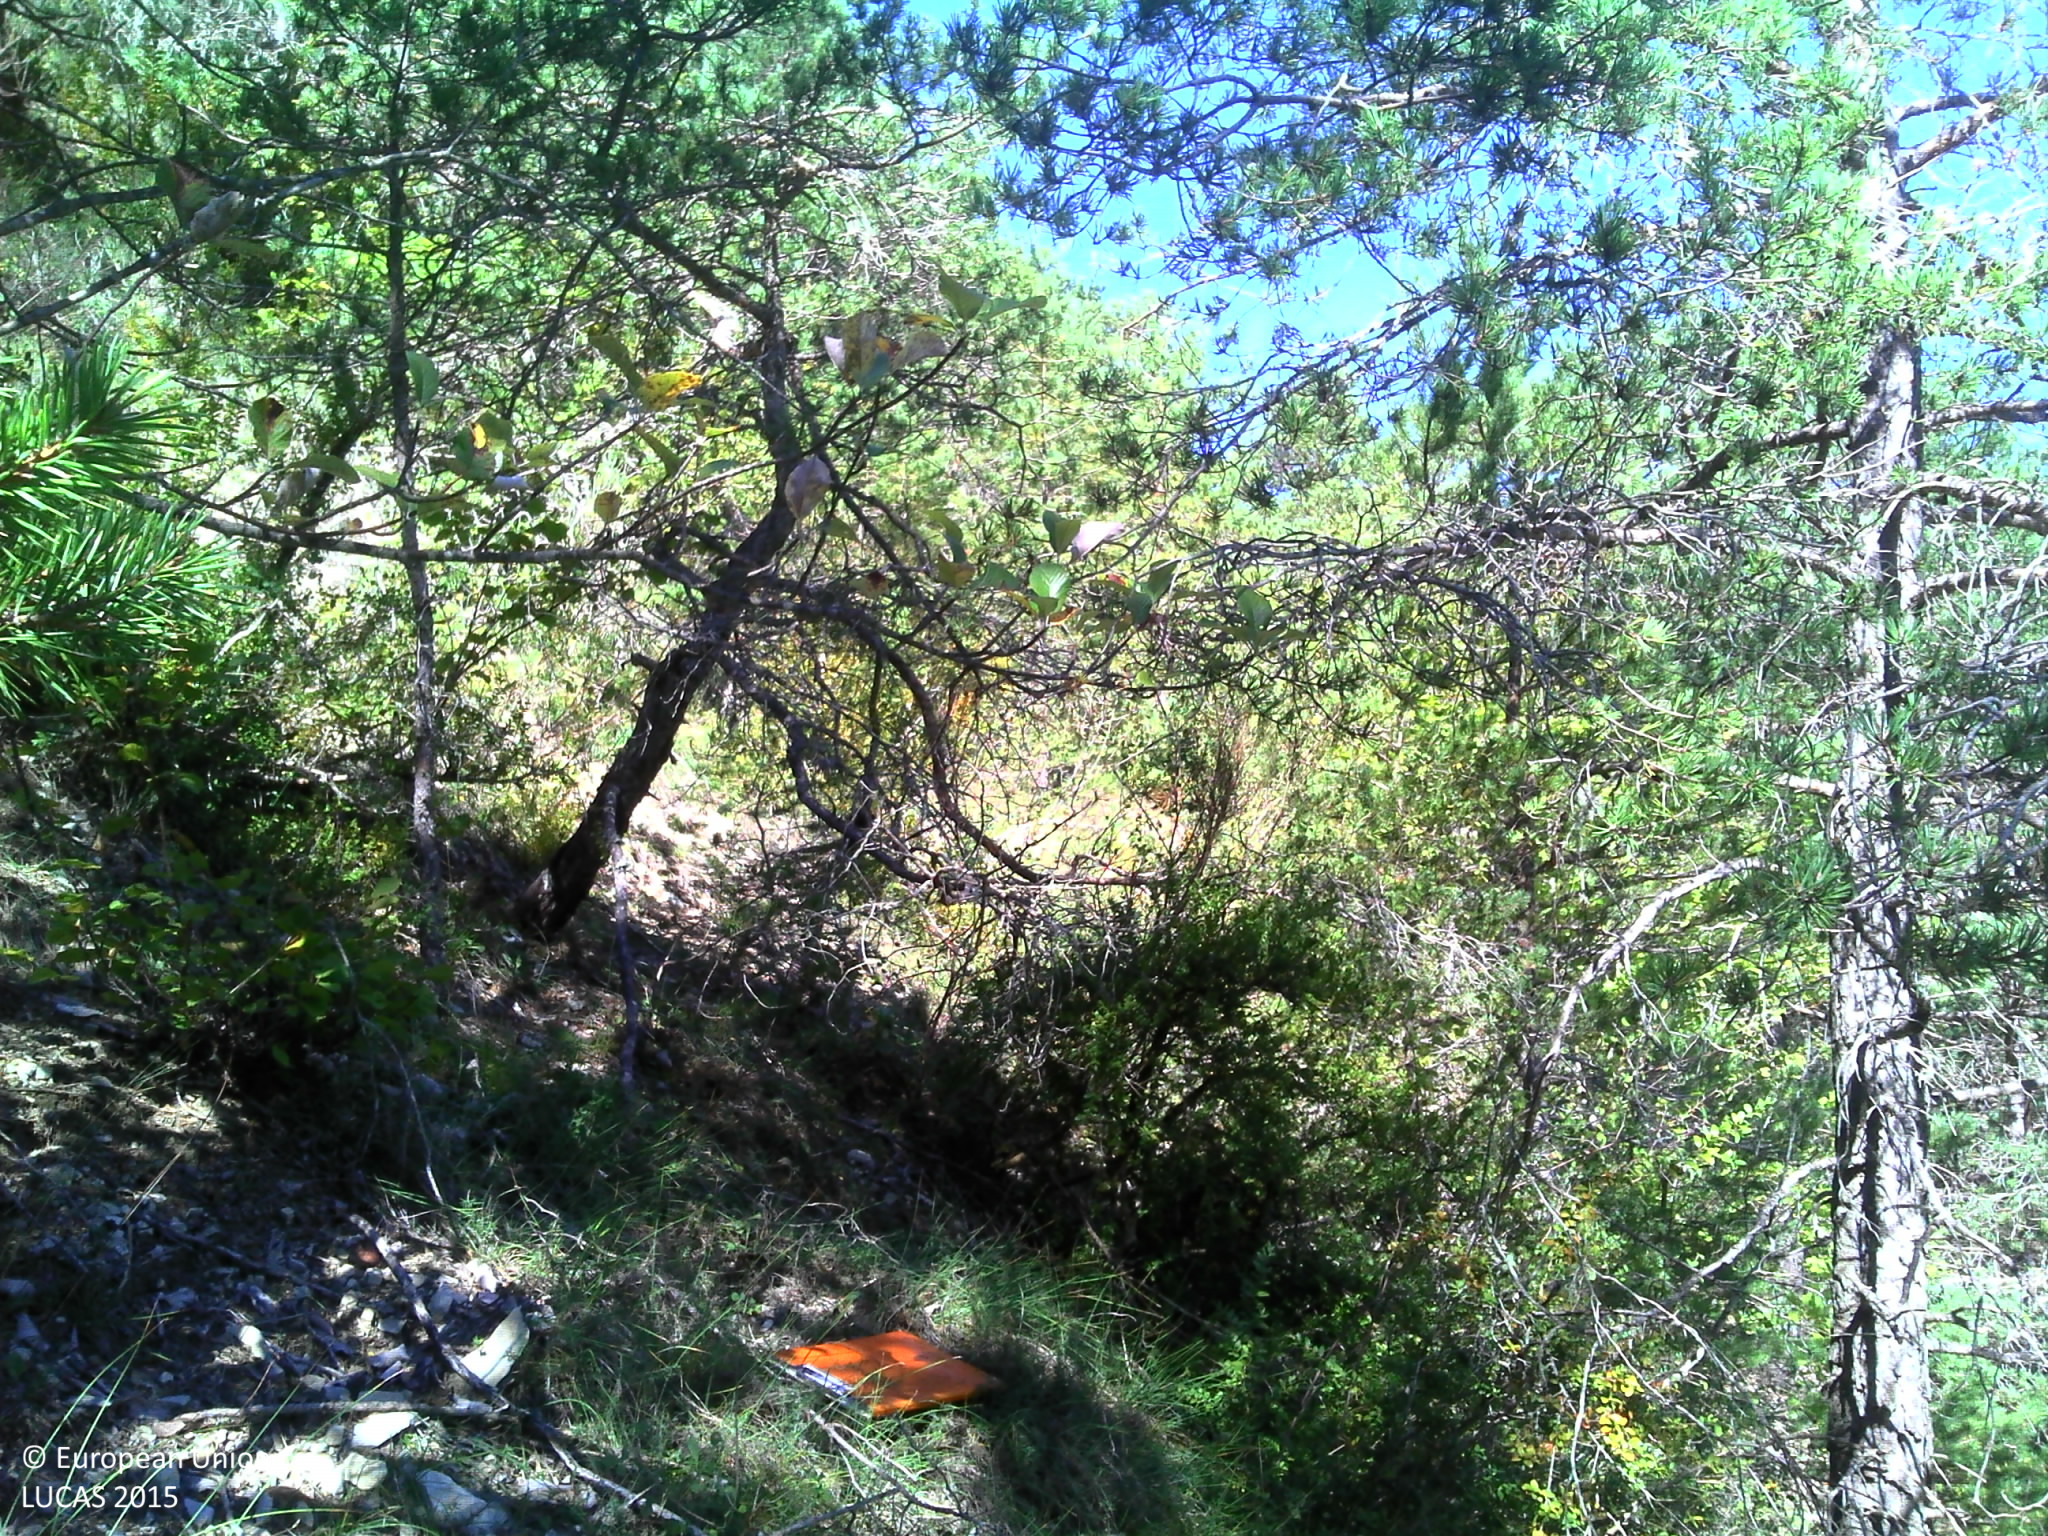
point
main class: Woodland
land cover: Pine dominated coniferous woodland
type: coniferous forest of the mediterranean region
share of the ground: > 75 %
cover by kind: coniferous forest trees 95 %, broadleaved forest trees 5 %
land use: Semi-natural and natural areas not in use
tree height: > 5 m
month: September
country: FR
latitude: 44.3265
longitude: 5.5307
